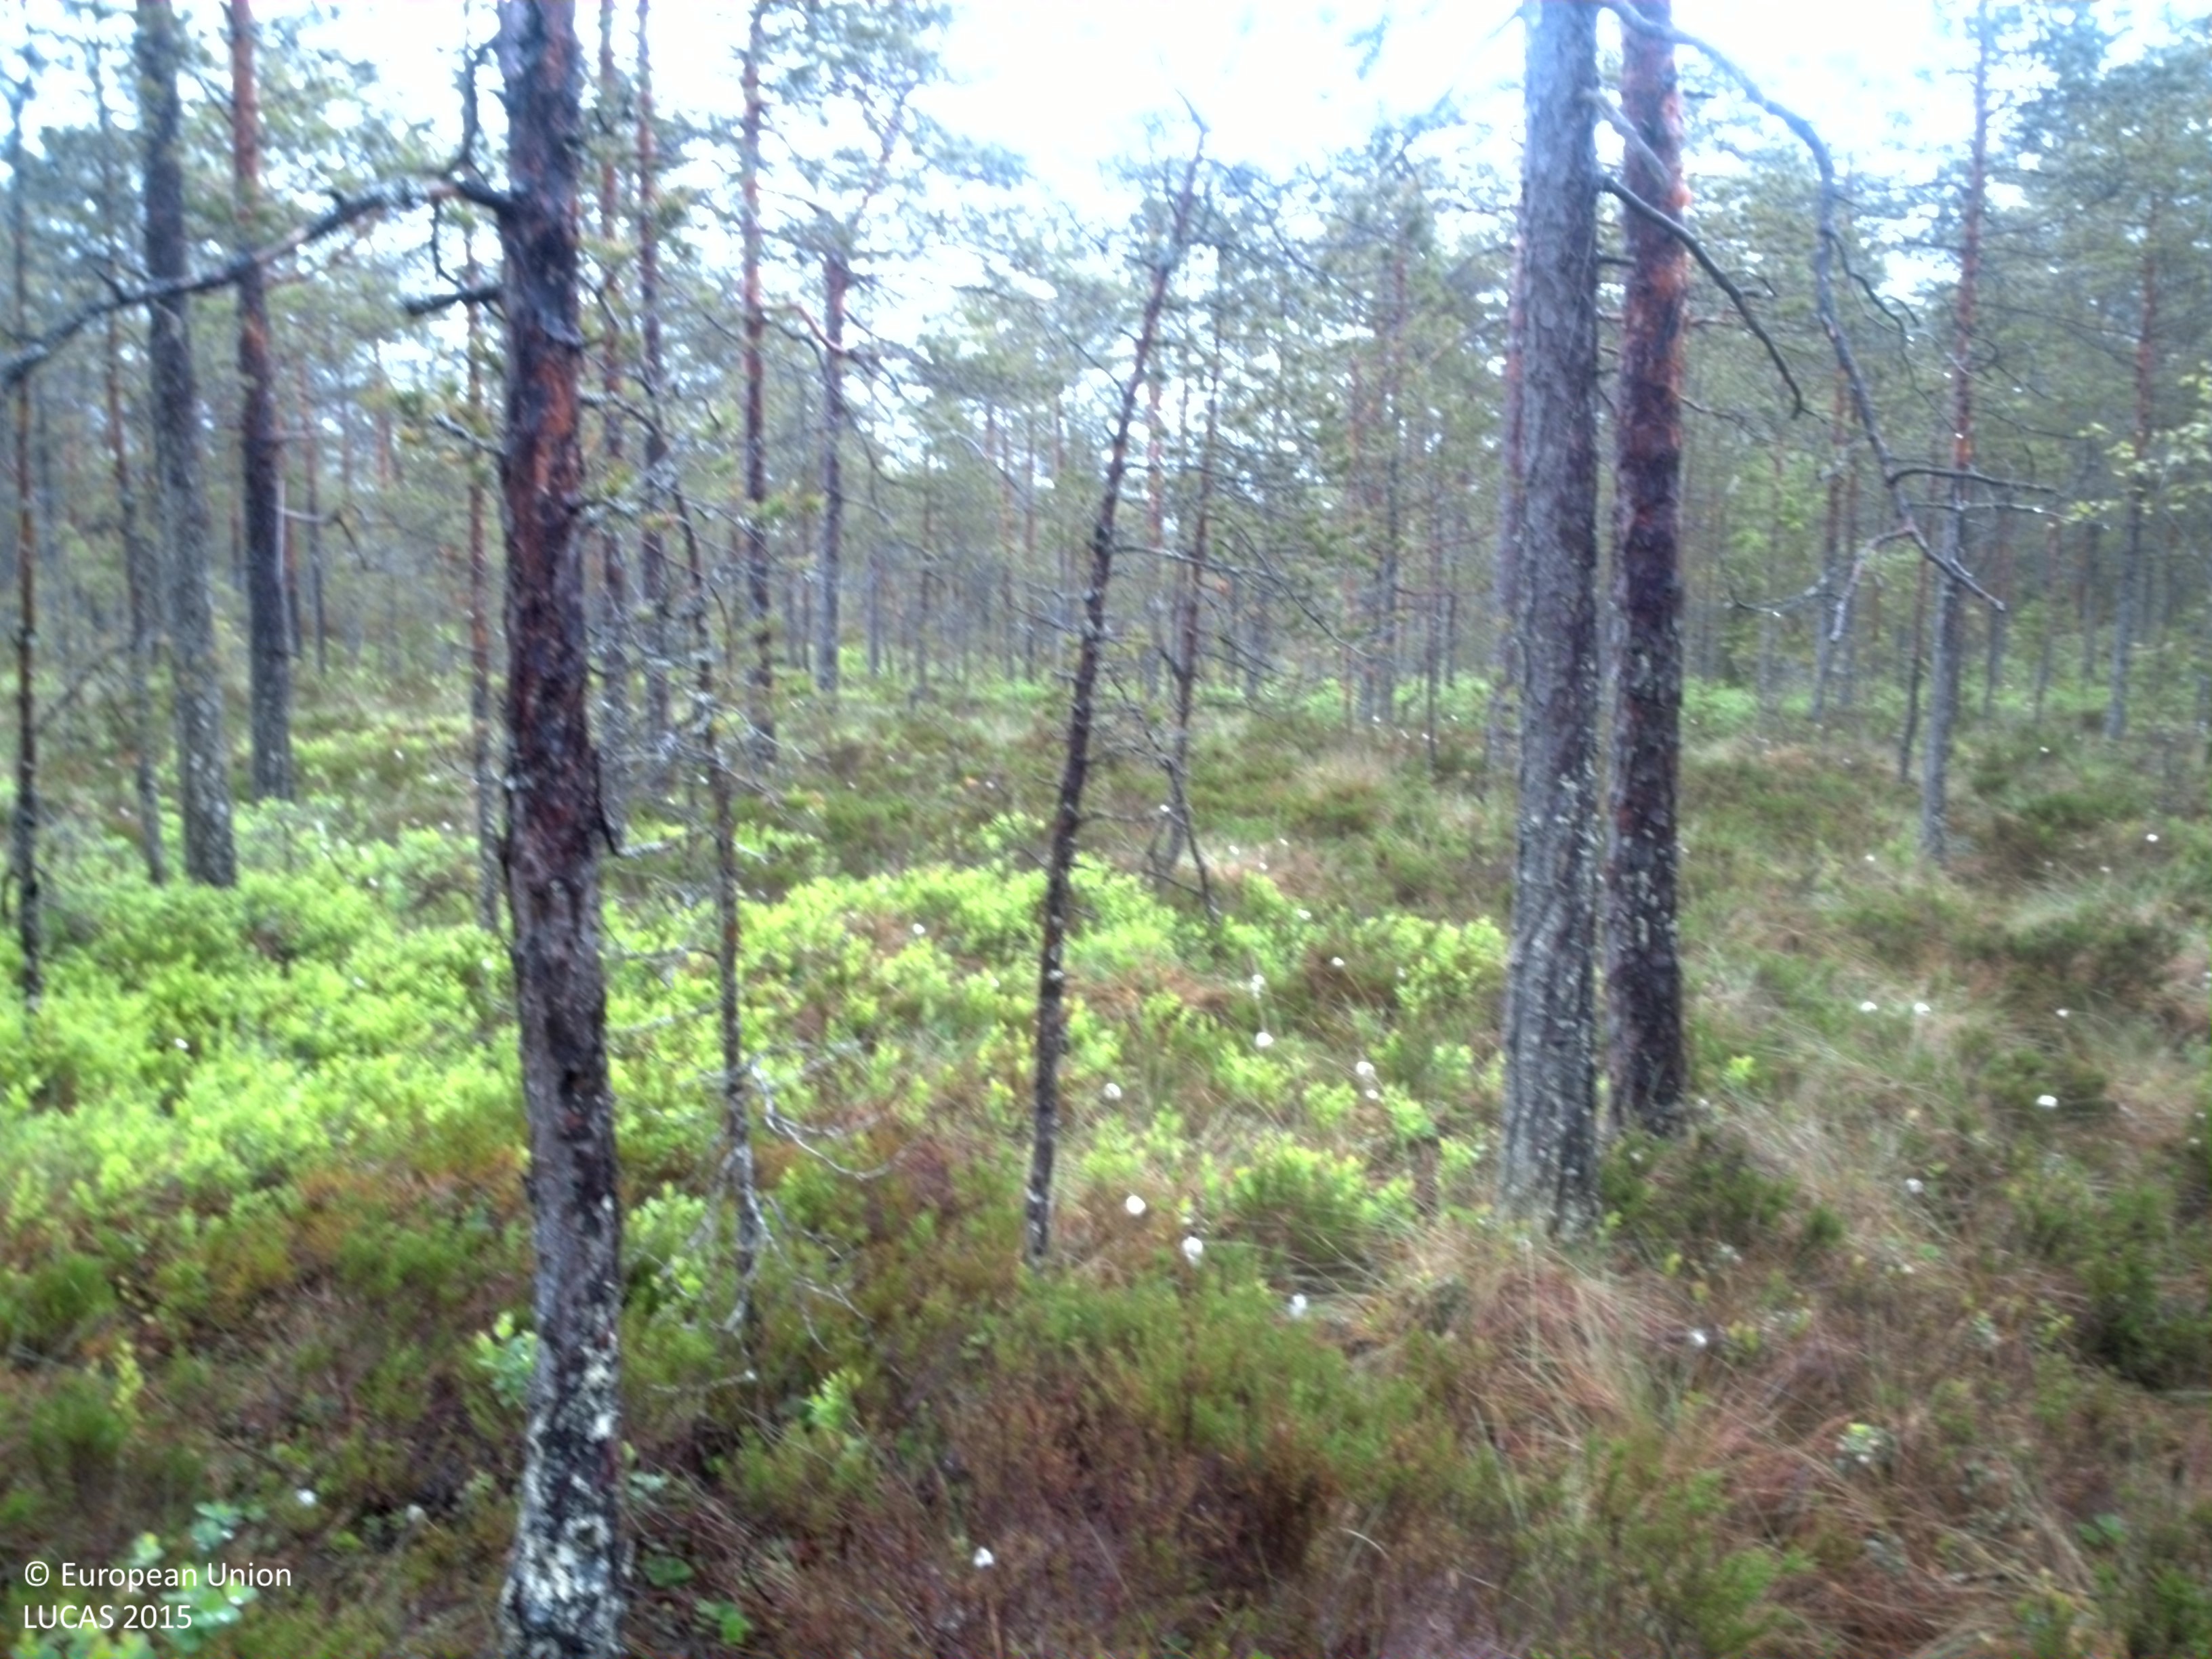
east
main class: Woodland
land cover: Pine dominated coniferous woodland
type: boreal forest
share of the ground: 25 - 50 %
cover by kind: coniferous forest trees 50 %, shrubs 25 %, lichens and mosses 20 %, herbaceous plants 5 %
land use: Forestry
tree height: > 5 m
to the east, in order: Pine dominated coniferous woodland
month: June
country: SE
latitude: 59.6591
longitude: 12.2125
